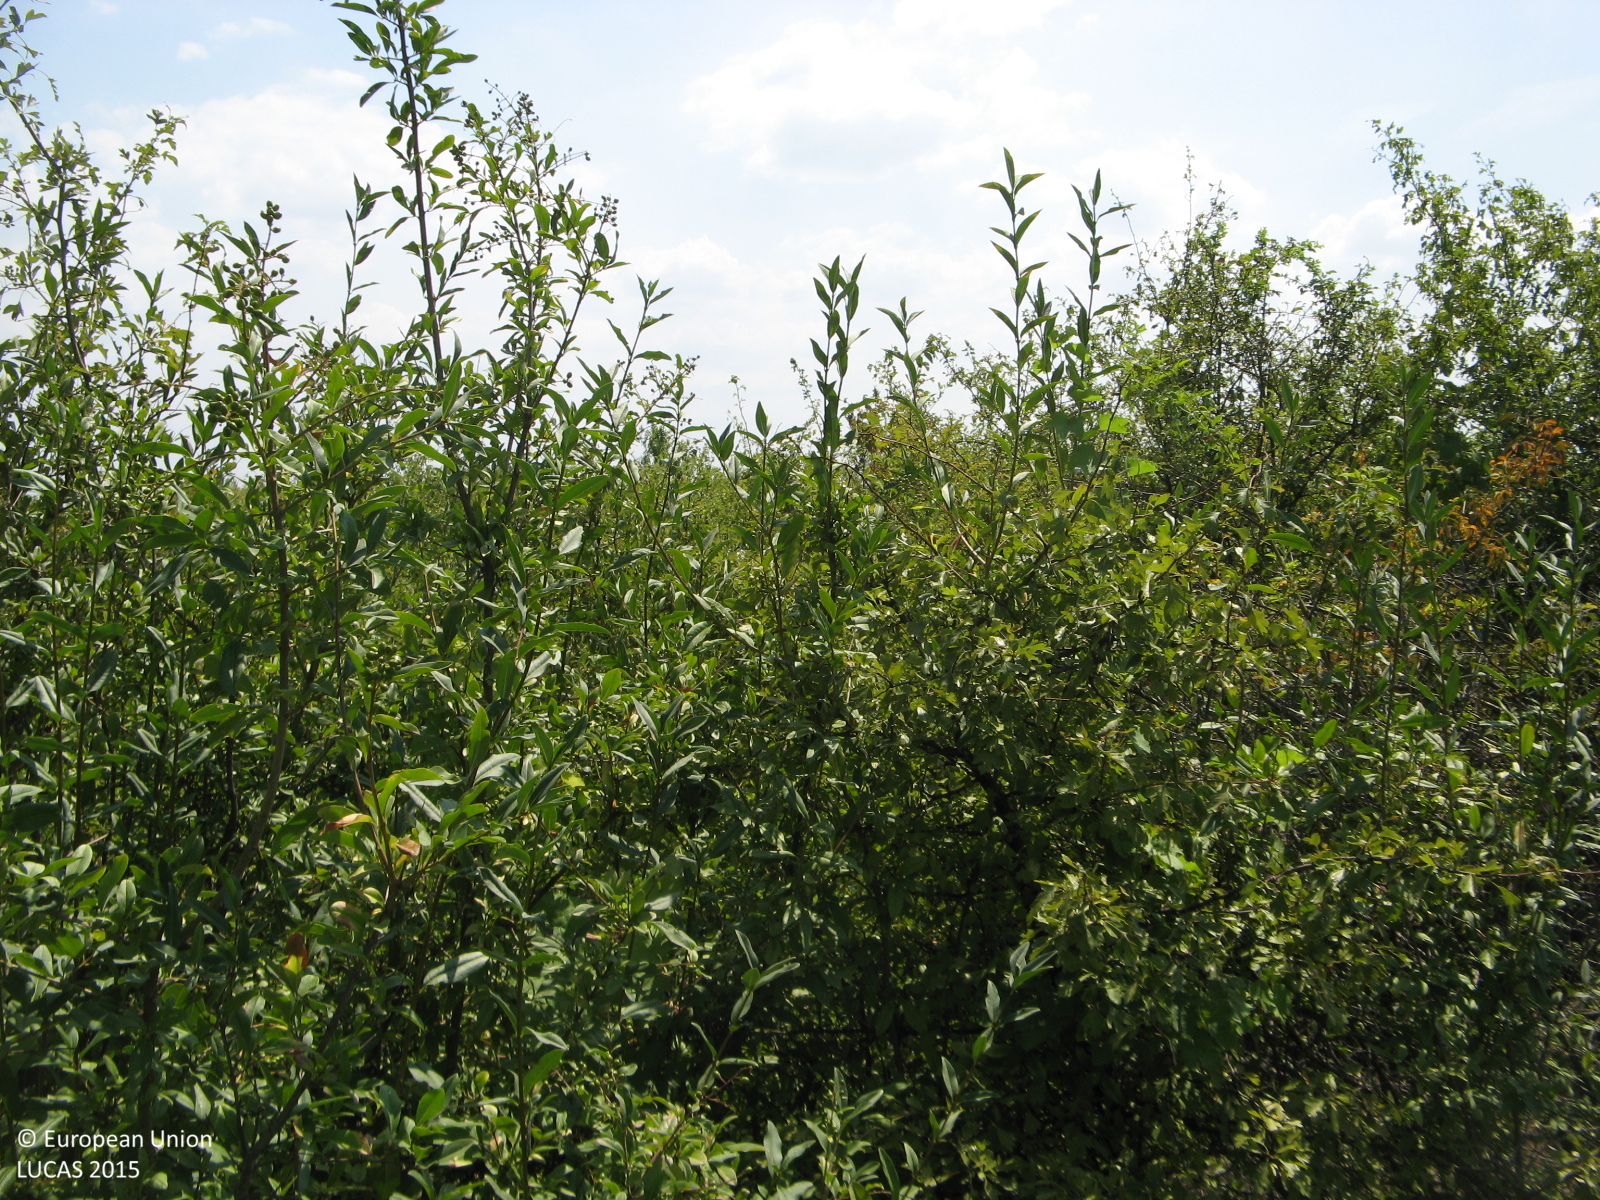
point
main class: Shrubland
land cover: Shrubland with sparse tree cover
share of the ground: > 75 %
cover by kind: shrubs 90 %, broadleaved forest trees 5 %, herbaceous plants 5 %
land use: Abandoned areas
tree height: < 5 m
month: August
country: BG
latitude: 43.3739
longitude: 25.2933
